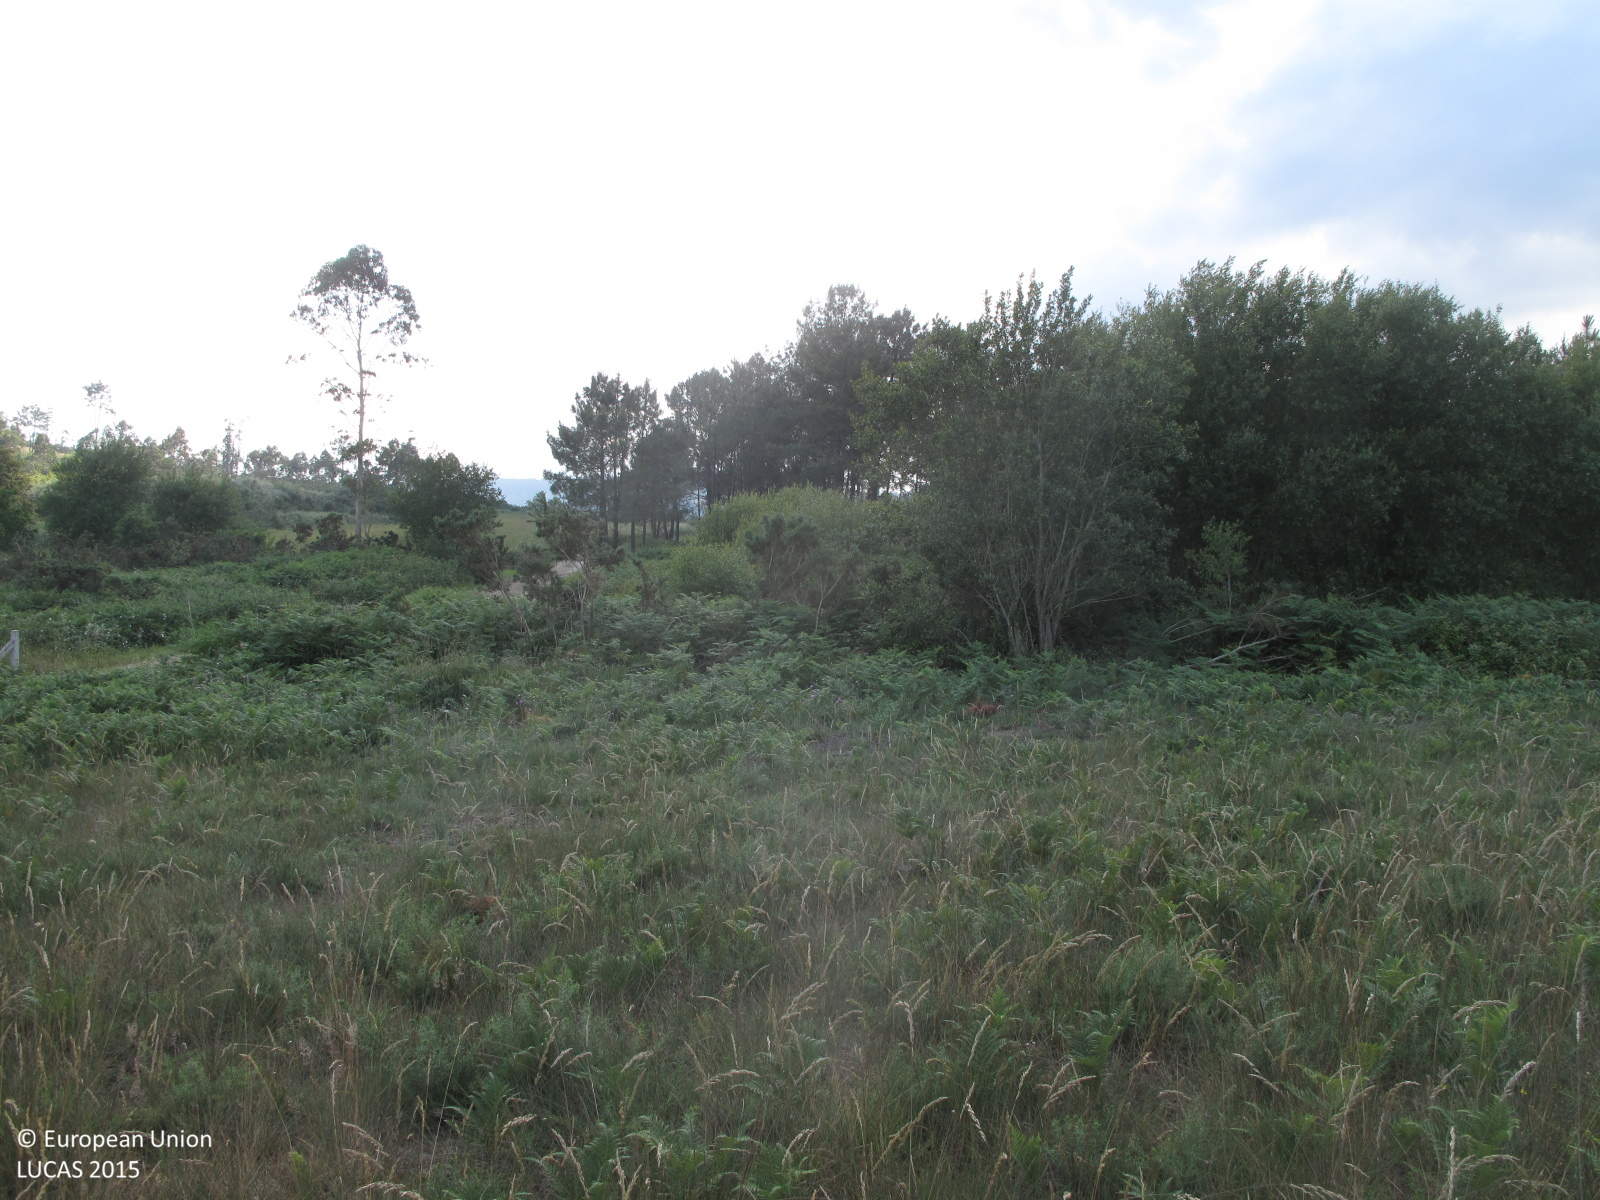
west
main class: Shrubland
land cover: Shrubland without tree cover
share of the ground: 10 - 25 %
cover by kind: herbaceous plants 90 %, shrubs 10 %
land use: Abandoned areas
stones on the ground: < 10 %
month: June
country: ES
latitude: 42.9023
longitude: -8.5371
